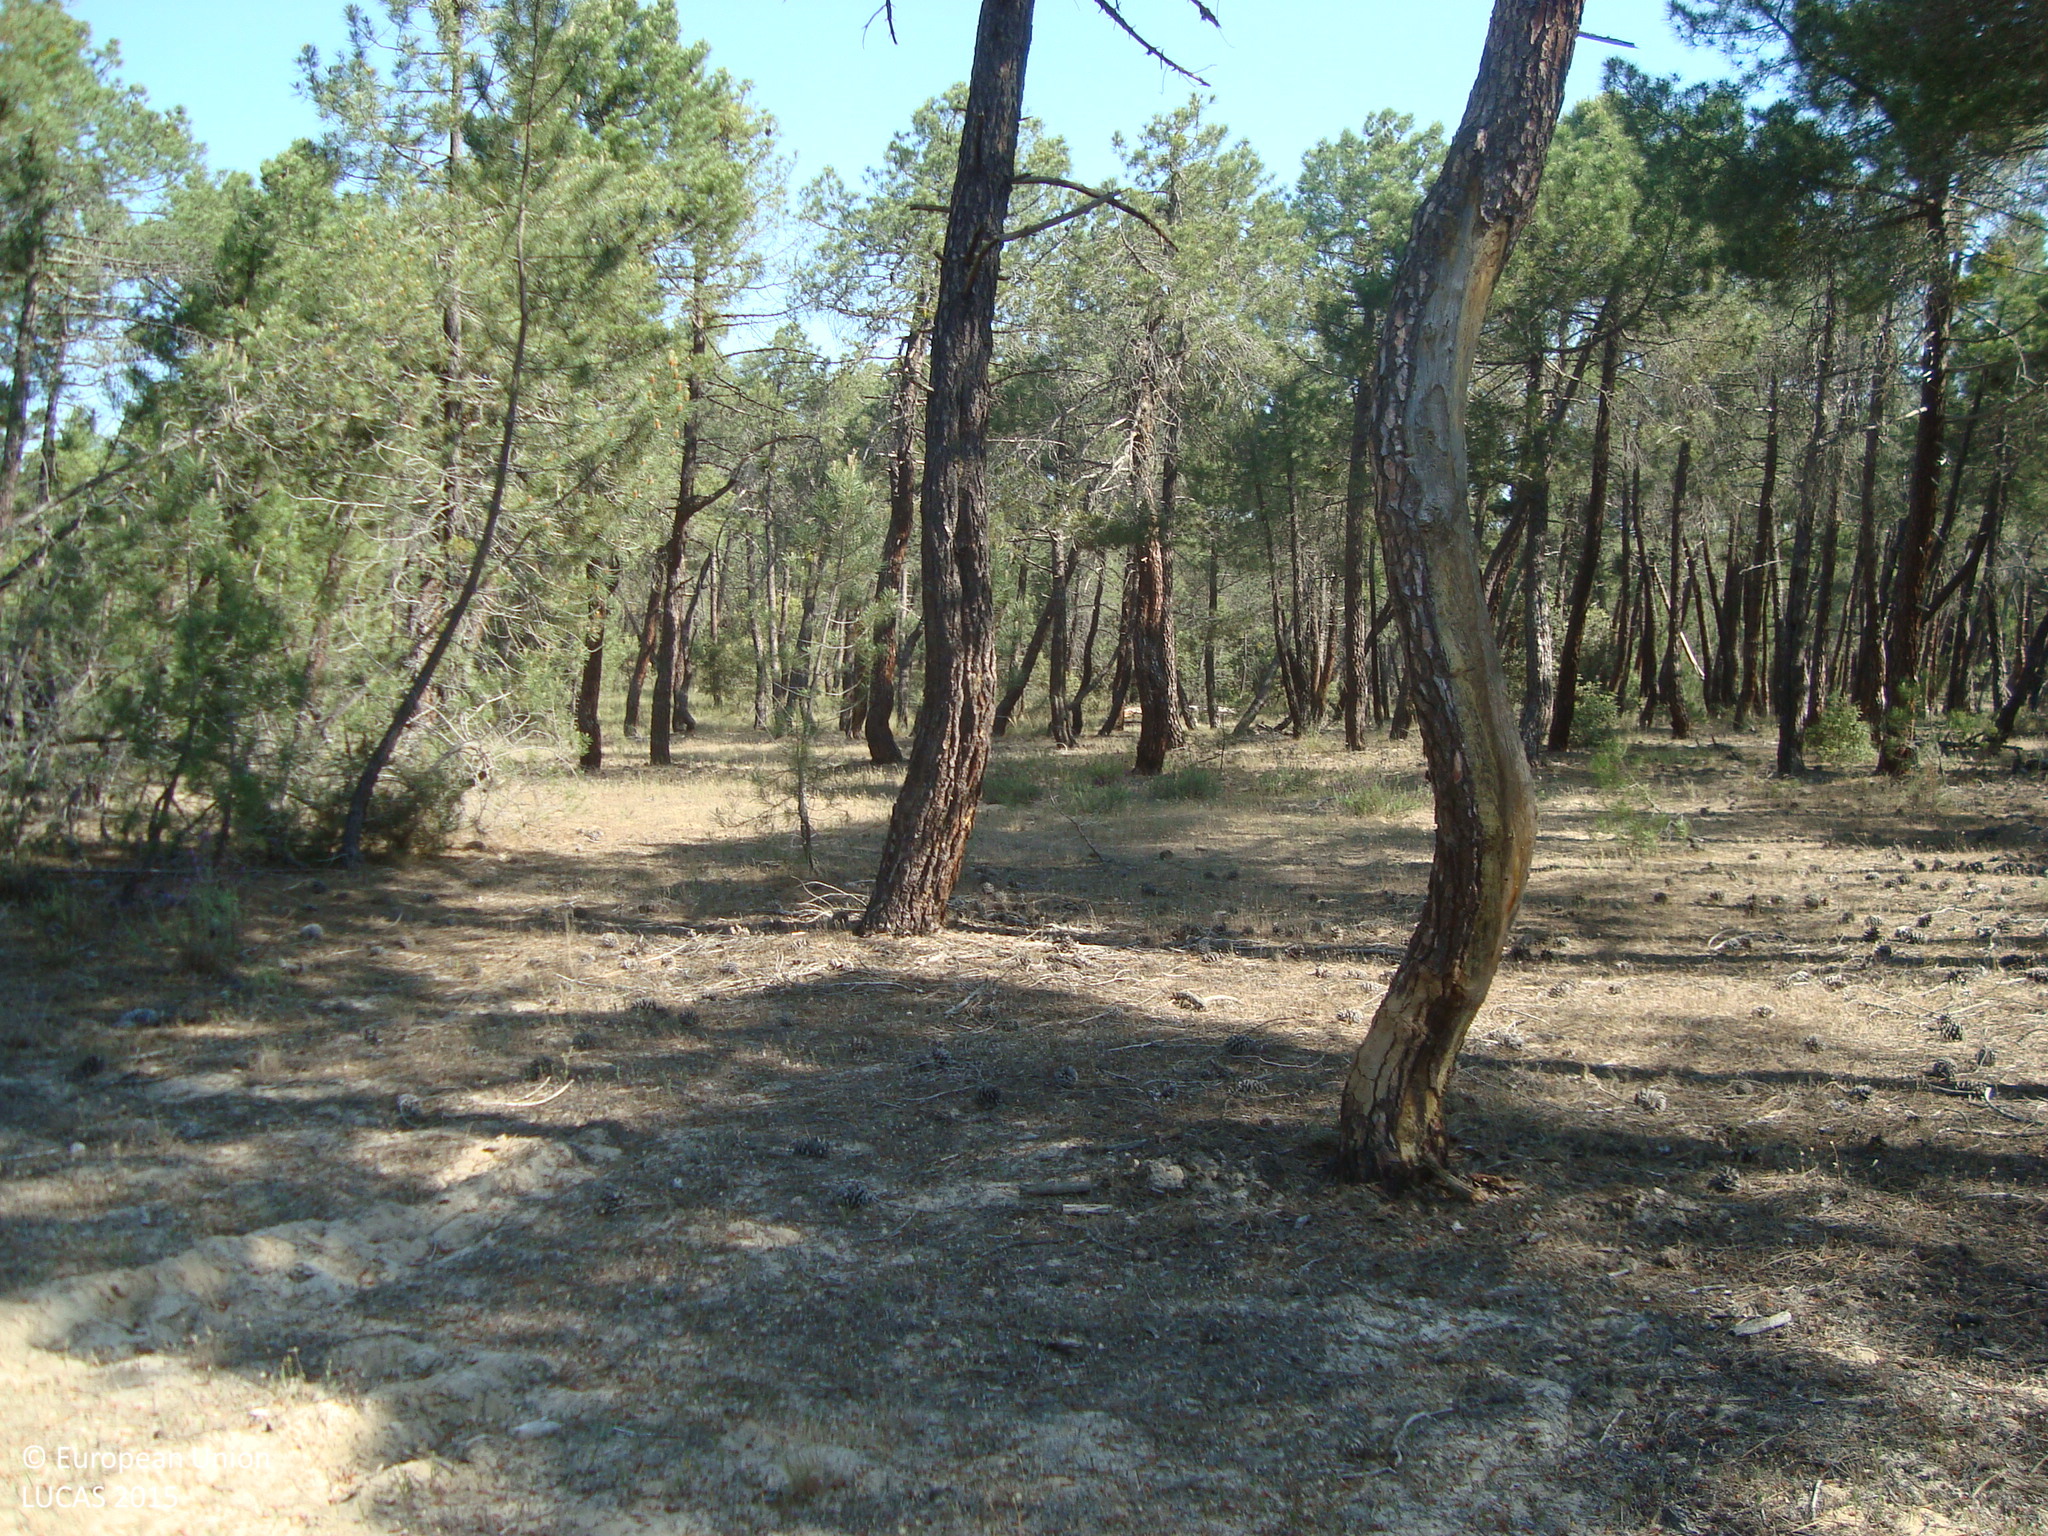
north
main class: Woodland
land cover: Pine dominated coniferous woodland
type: coniferous forest of the mediterranean region
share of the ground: 50 - 75 %
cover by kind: coniferous forest trees 55 %, unconsolidated bare surface 20 %, shrubs 10 %, herbaceous plants 10 %, broadleaved forest trees 5 %
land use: Forestry
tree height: > 5 m
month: June
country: ES
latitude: 41.7317
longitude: -3.6015
